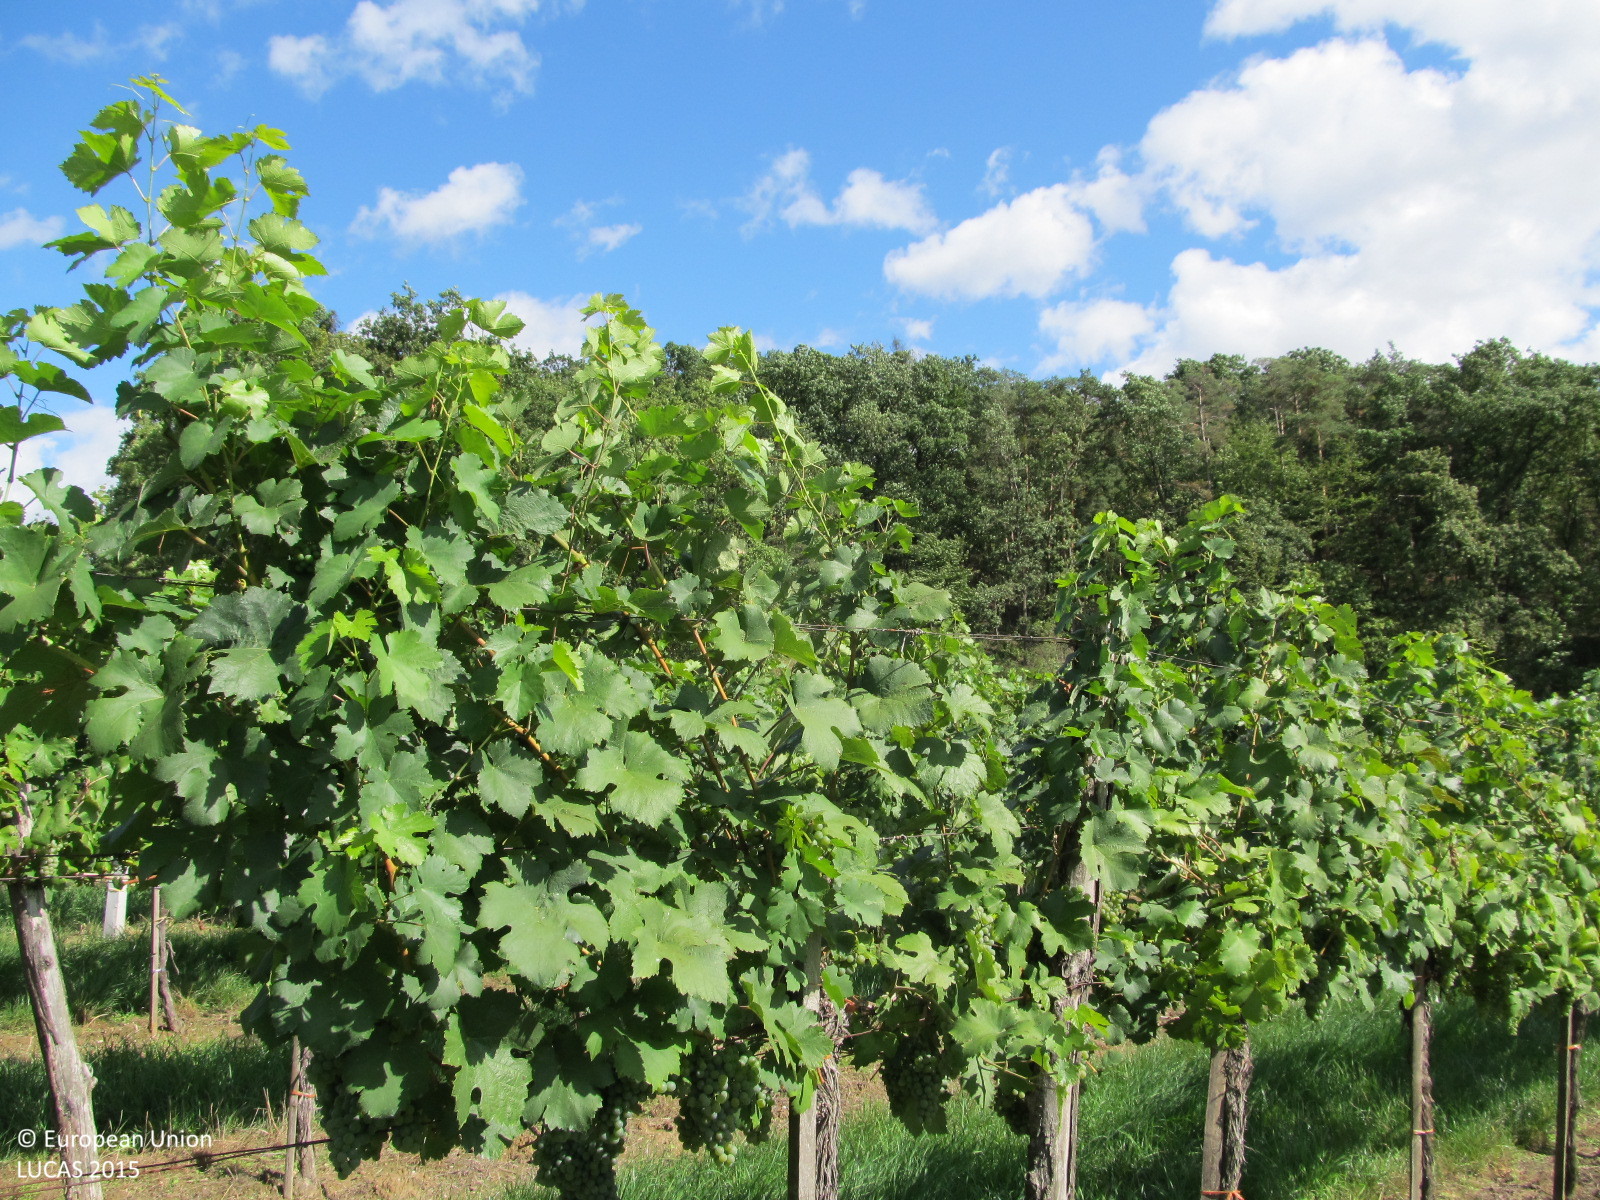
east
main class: Cropland
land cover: Vineyards
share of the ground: 25 - 50 %
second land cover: Grassland without tree/shrub cover
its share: 50 - 75 %
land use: Agriculture (excluding fallow land and kitchen gardens)
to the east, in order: Vineyards; Grassland without tree/shrub cover; Tracks; Grass margins; Temporary grasslands; Tracks; Grass margins; Lucerne; Other mixed woodland; Broadleaved woodland
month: September
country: AT
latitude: 48.5004
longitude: 15.8640
